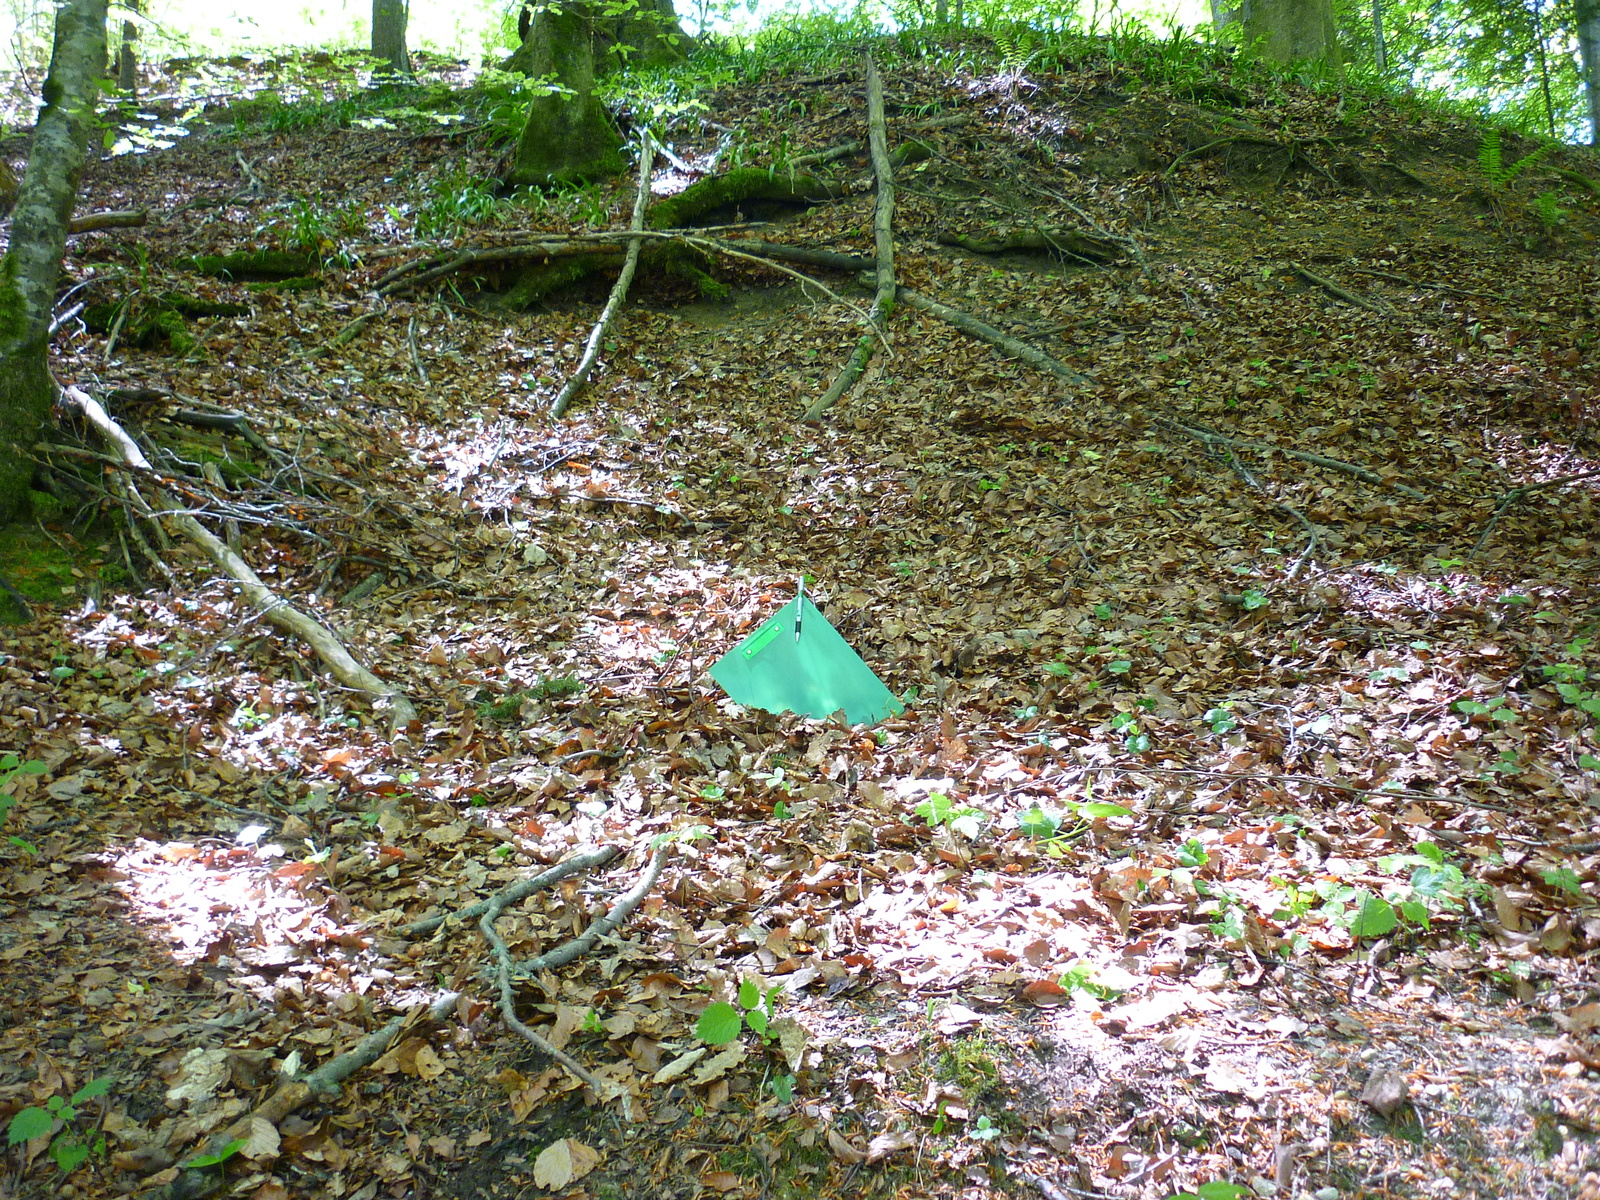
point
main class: Woodland
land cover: Broadleaved woodland
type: mountainous beech forest
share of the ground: > 75 %
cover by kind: broadleaved forest trees 85 %, coniferous forest trees 10 %, herbaceous plants 5 %
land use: Forestry
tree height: > 5 m
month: May
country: AT
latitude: 47.6692
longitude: 14.7810
